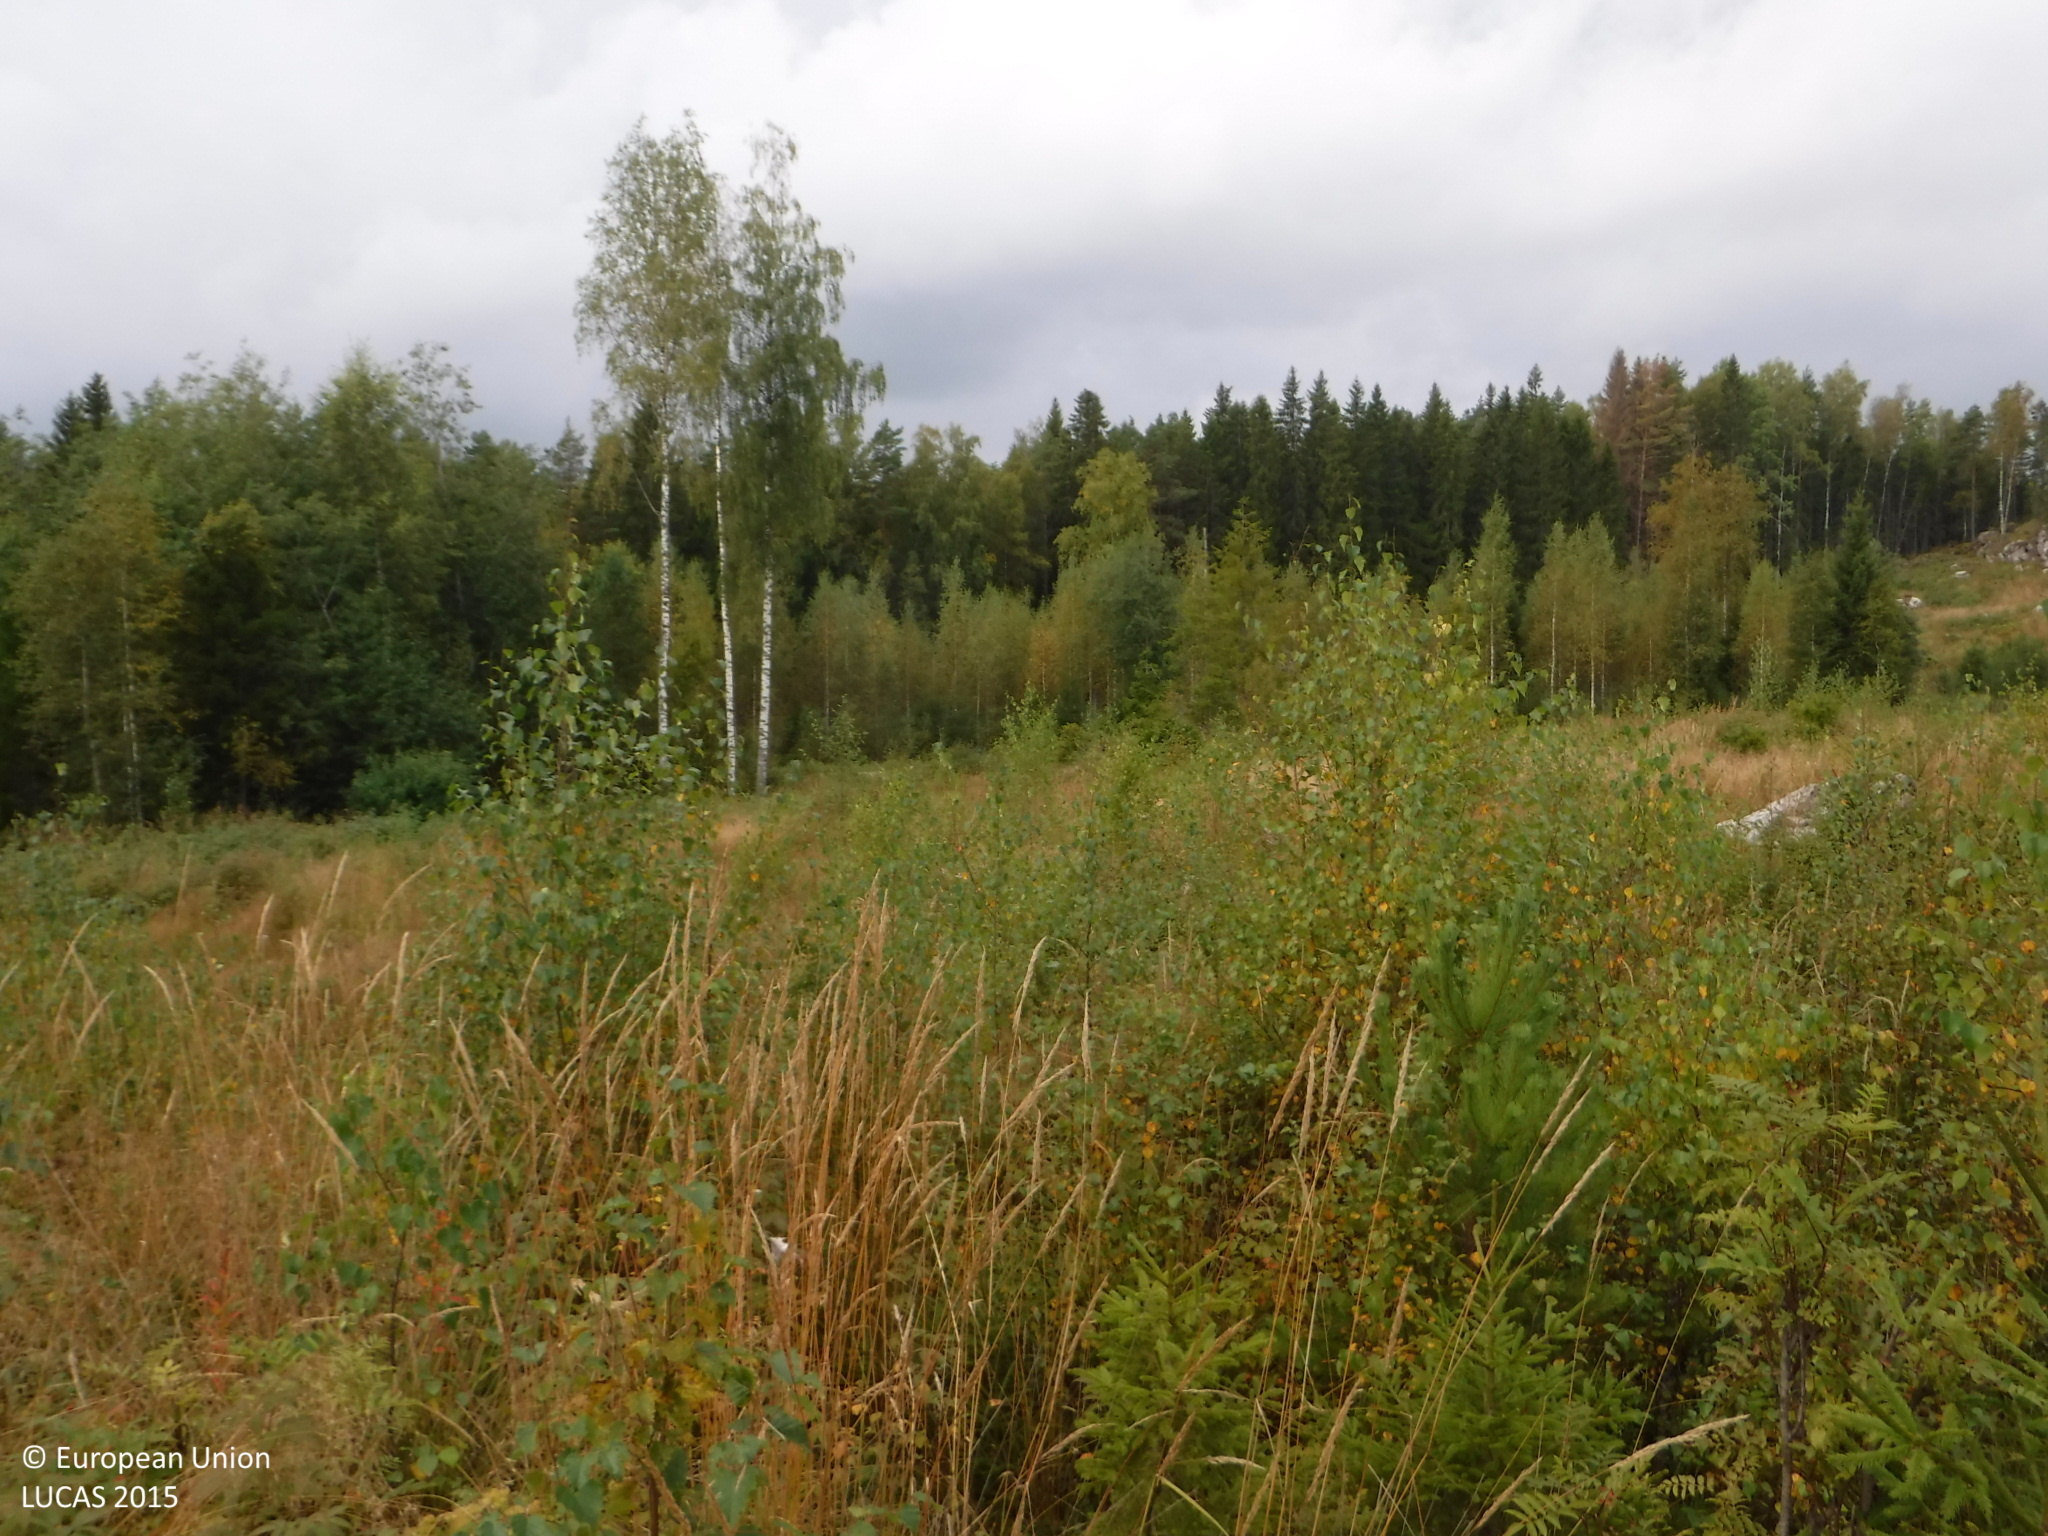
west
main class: Woodland
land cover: Spruce dominated mixed woodland
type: boreal forest
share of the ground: 10 - 25 %
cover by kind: herbaceous plants 60 %, shrubs 20 %, broadleaved forest trees 10 %, coniferous forest trees 5 %, lichens and mosses 5 %
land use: Forestry
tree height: < 5 m
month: September
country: FI
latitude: 61.2917
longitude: 22.6264
